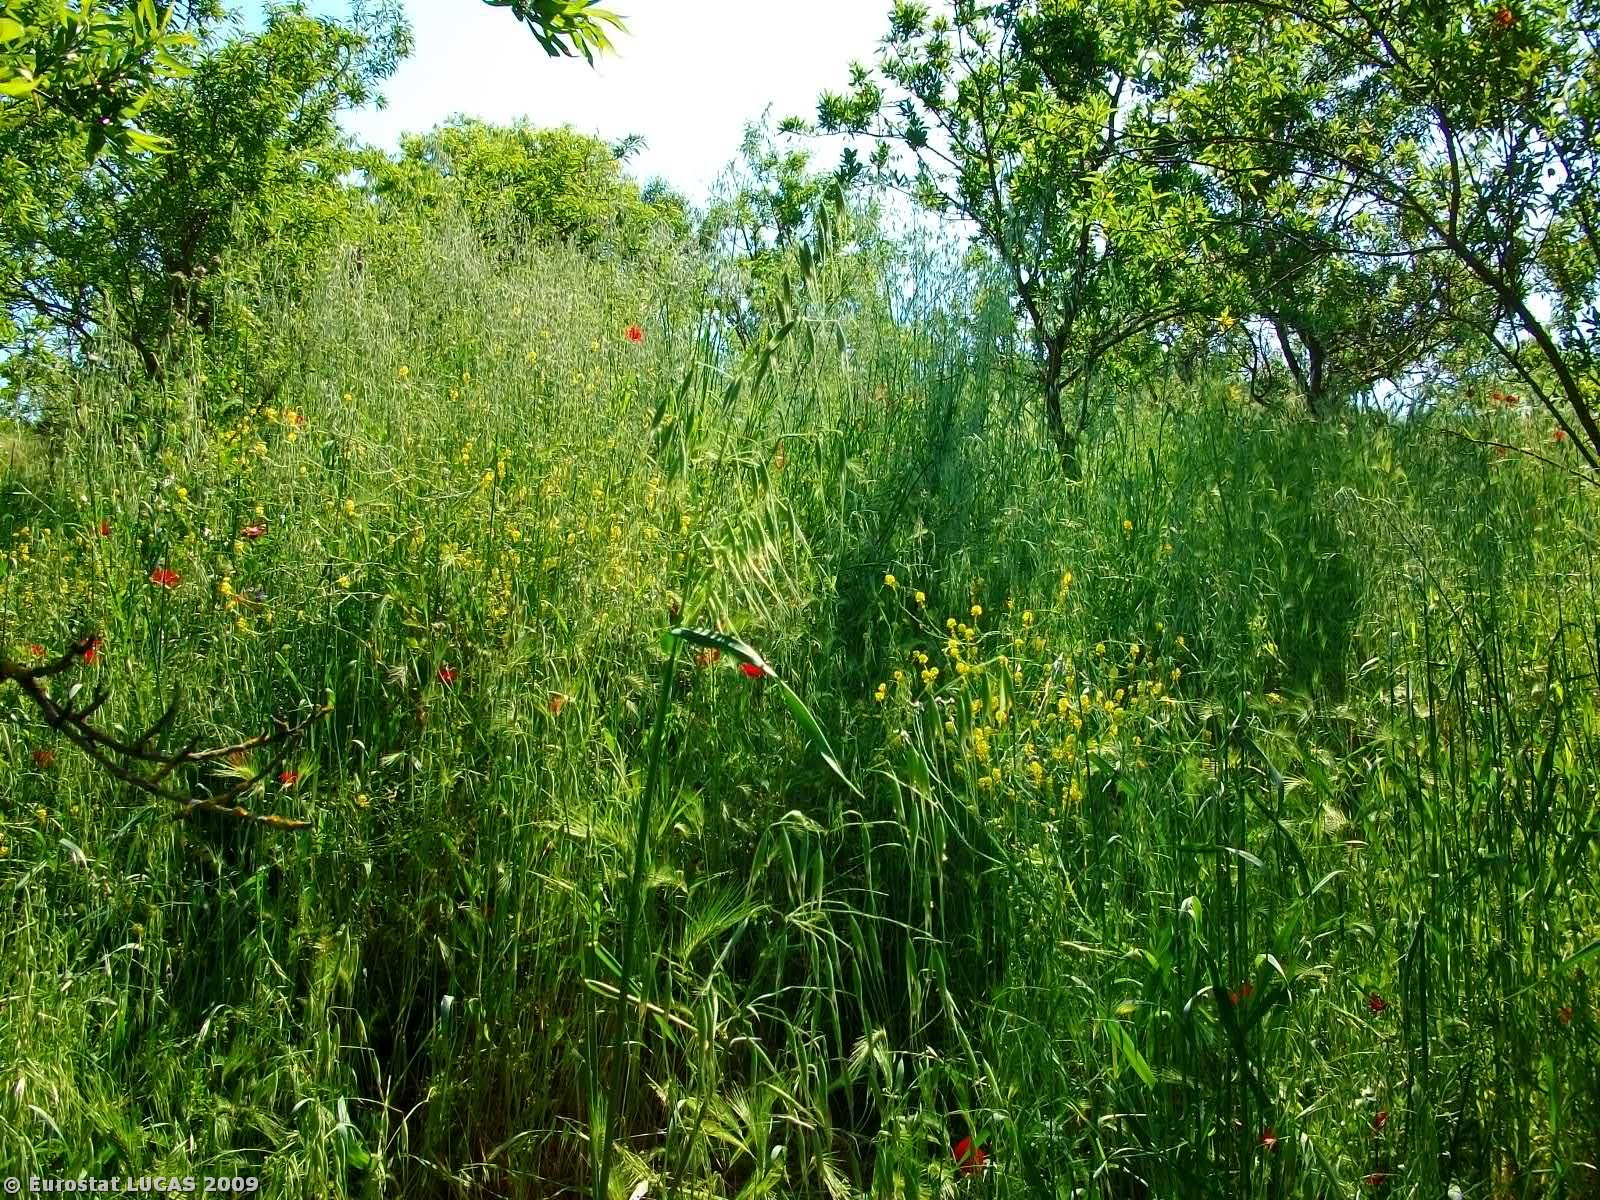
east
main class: Cropland
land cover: Nuts trees
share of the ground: 50 - 75 %
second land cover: Grassland with sparse tree/shrub cover
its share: > 75 %
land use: Agriculture (excluding fallow land and kitchen gardens)
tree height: > 5 m
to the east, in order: Nuts trees; Grassland with sparse tree/shrub cover; Paved roads, cycling and walking lanes; Grassland with sparse tree/shrub cover; Durum wheat
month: May
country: GR
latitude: 39.3772
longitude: 22.7475
